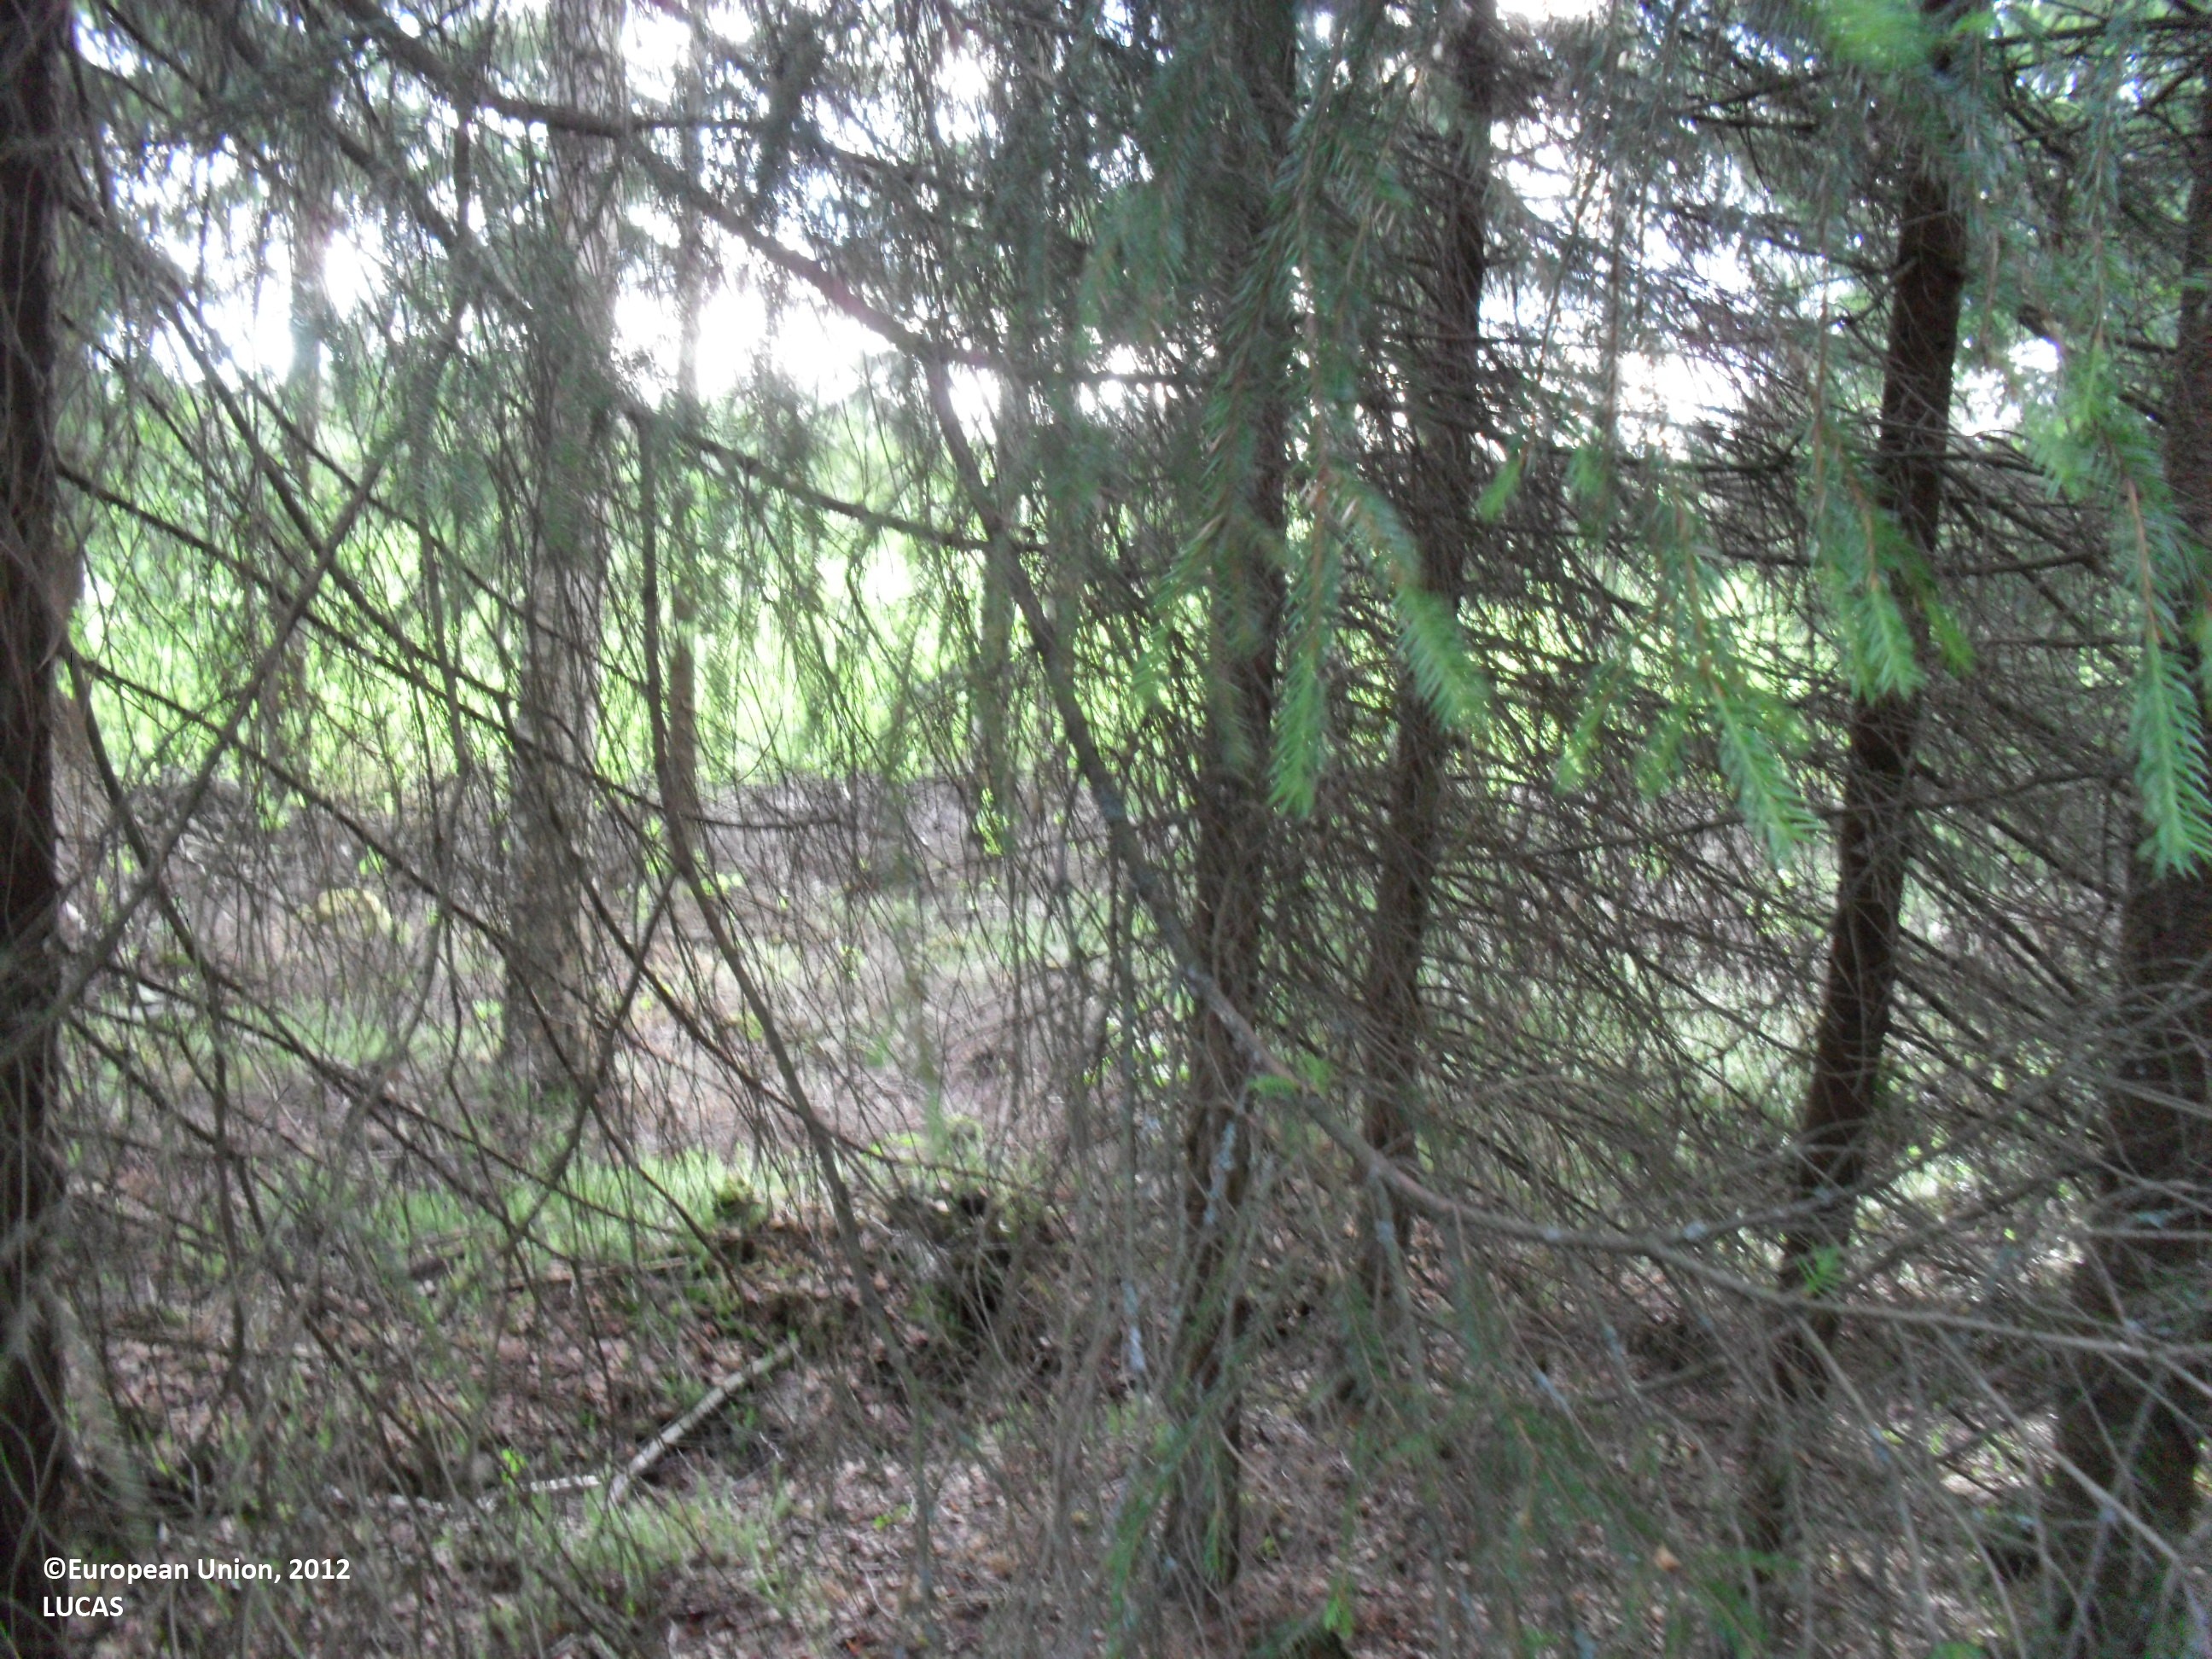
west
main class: Woodland
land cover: Spruce dominated mixed woodland
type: boreal forest
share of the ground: 50 - 75 %
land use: Forestry
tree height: > 5 m
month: June
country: FI
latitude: 63.0702
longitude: 23.0216
